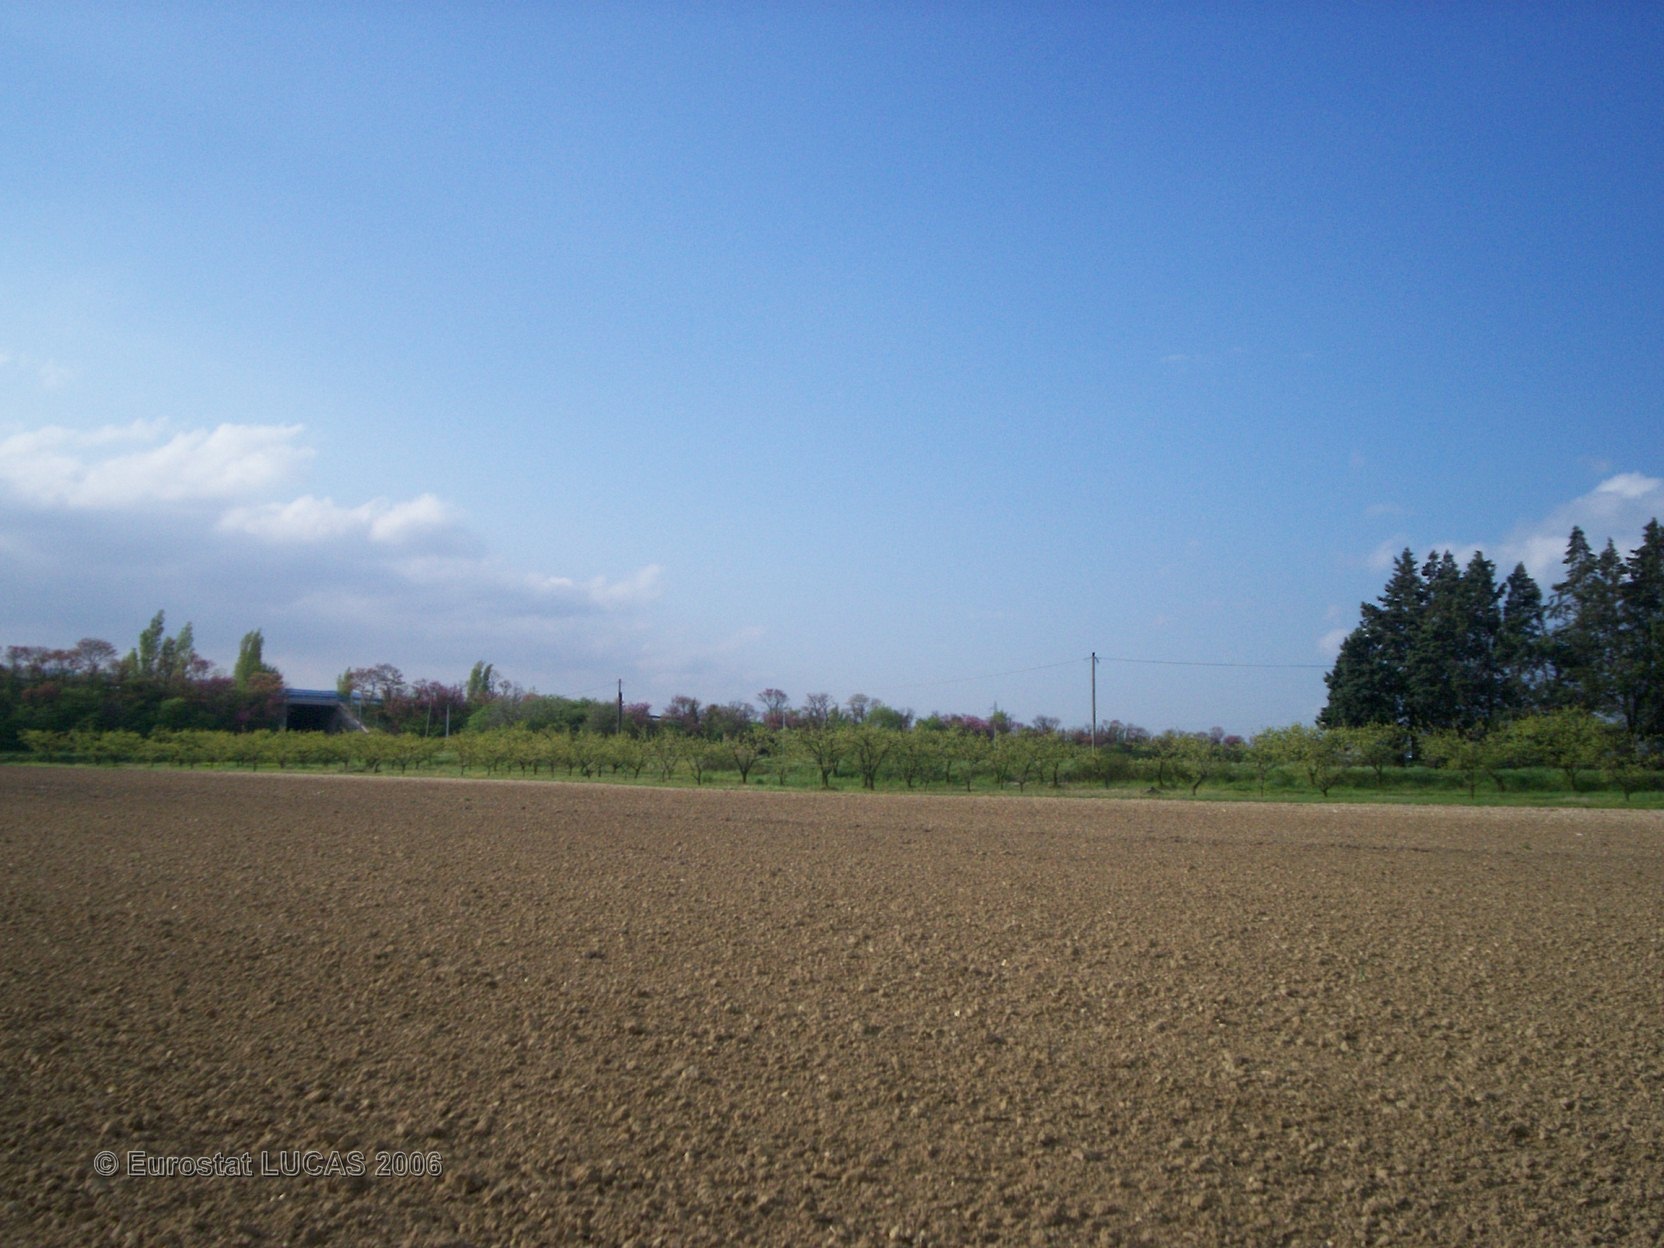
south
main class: Cropland
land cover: Sunflower
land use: Agriculture (excluding fallow land and kitchen gardens)
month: June
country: FR
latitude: 44.7809
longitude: 4.8120
